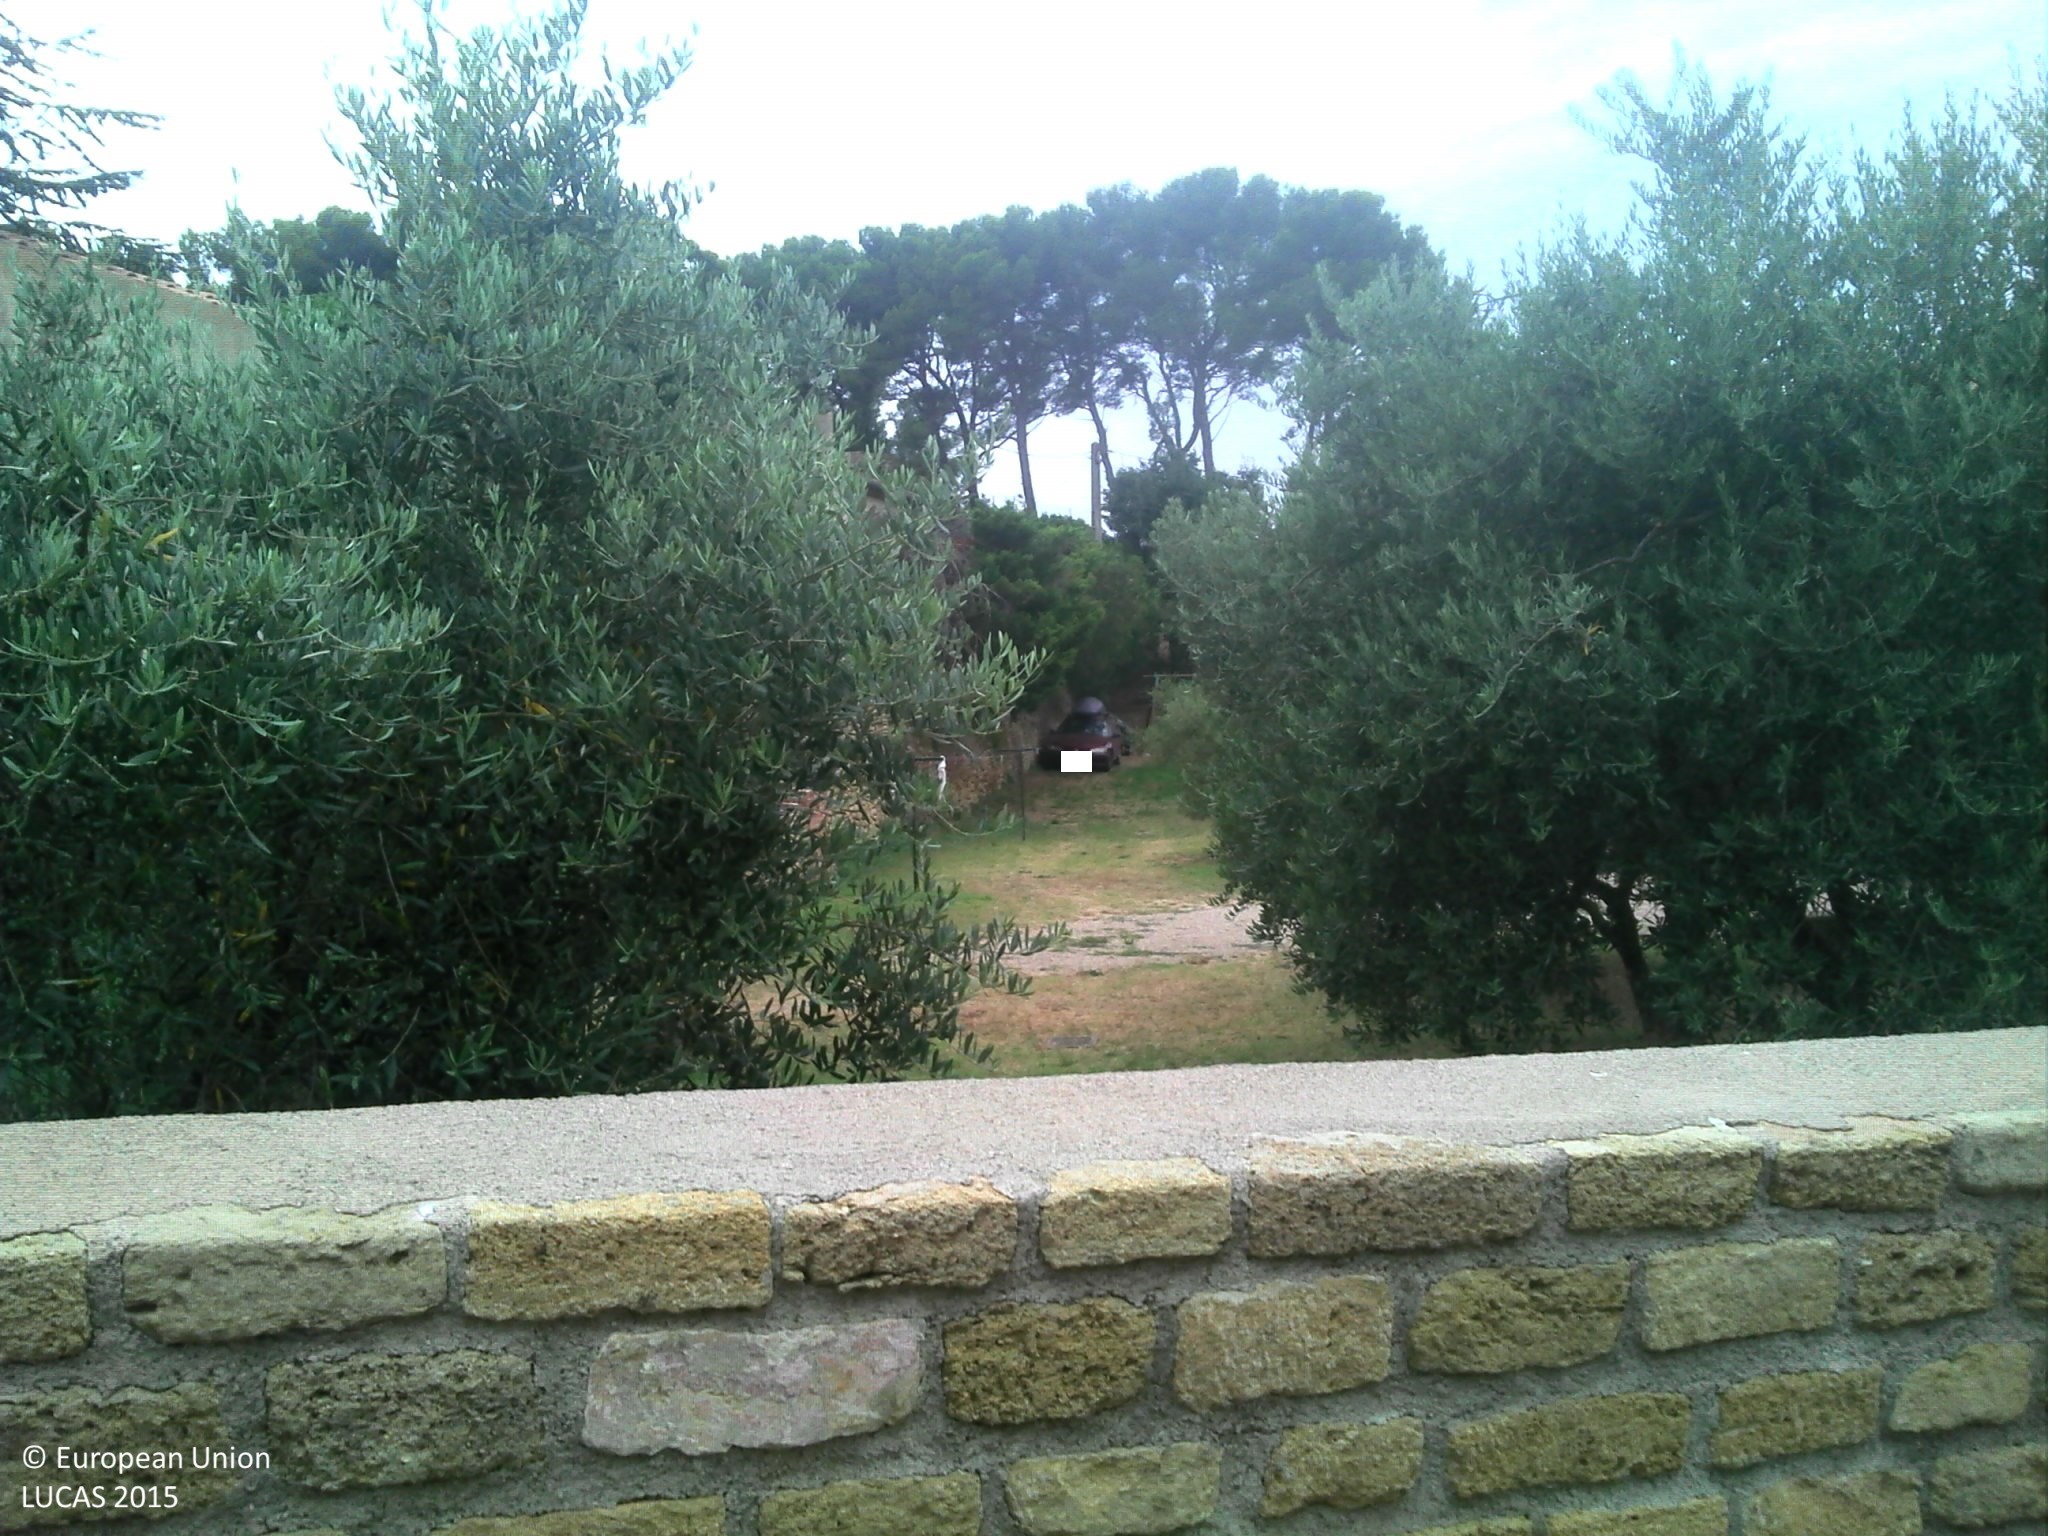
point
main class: Woodland
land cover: Other coniferous woodland
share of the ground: > 75 %
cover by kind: coniferous forest trees 30 %, herbaceous plants 25 %, consolidated bare surface 10 %
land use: Residential
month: July
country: FR
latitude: 43.5647
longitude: 5.0698
